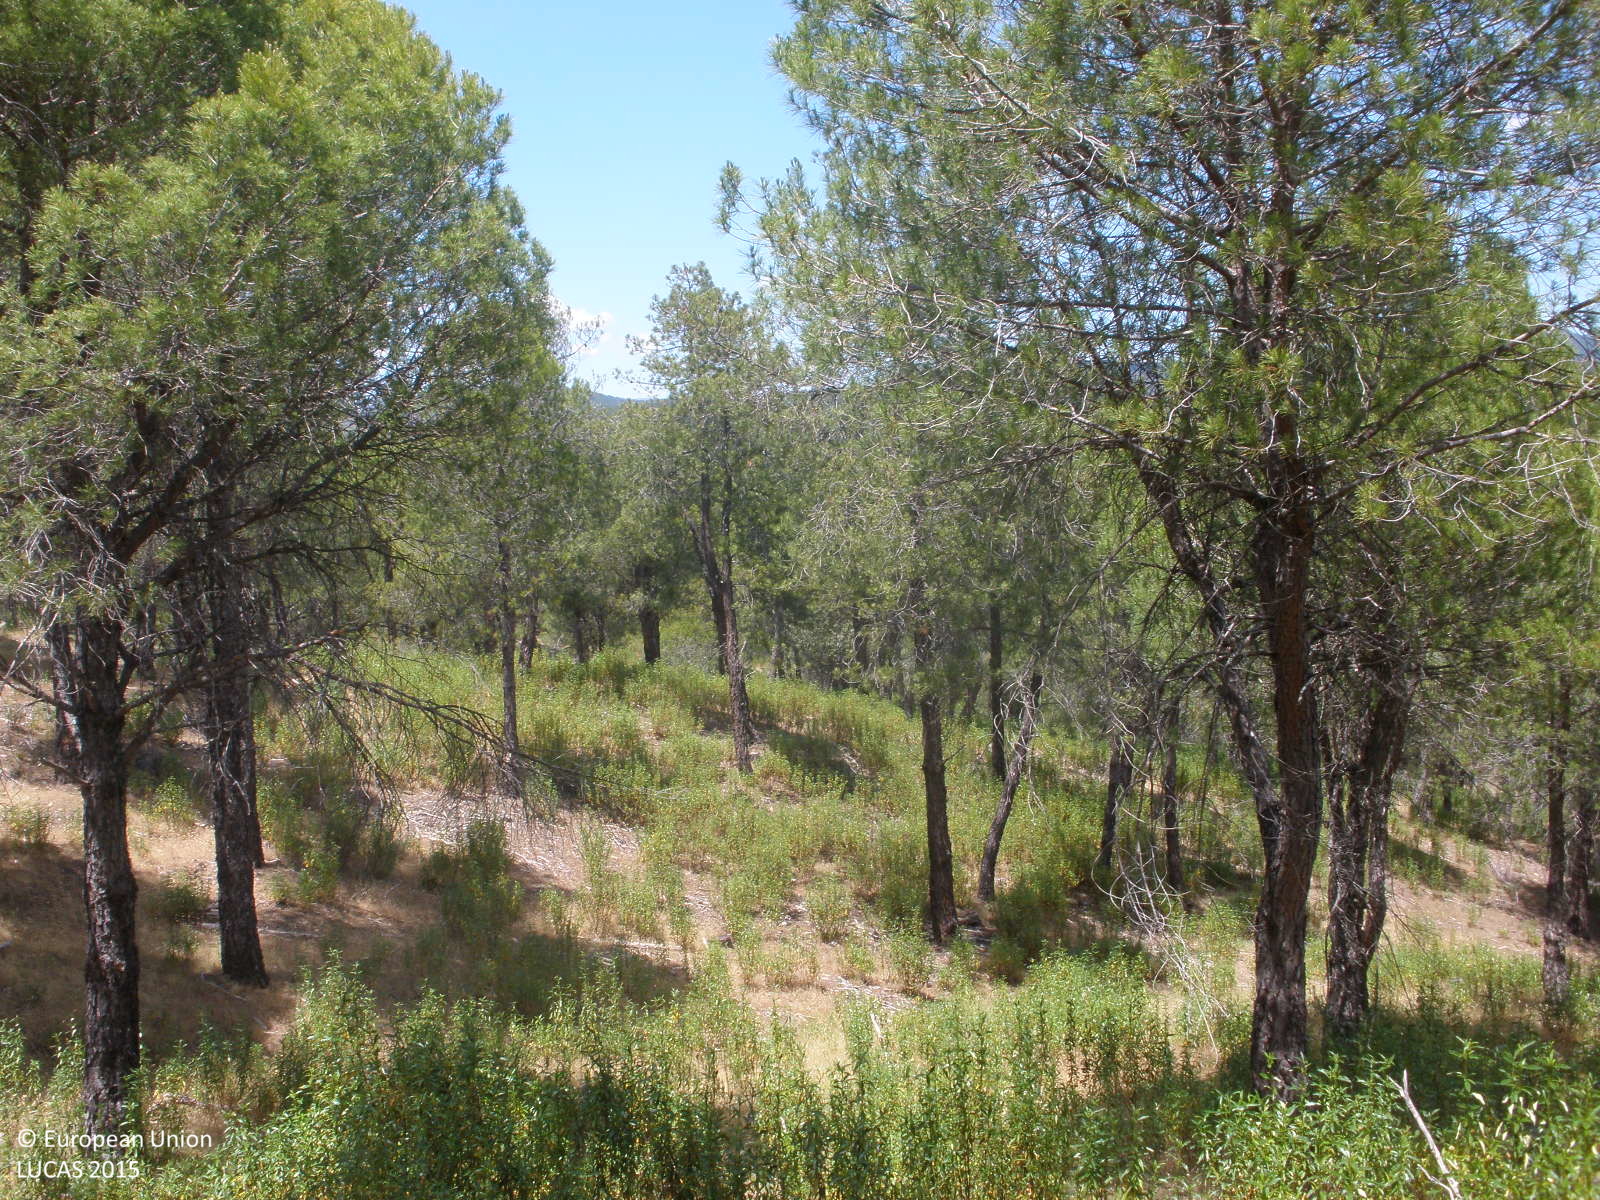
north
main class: Woodland
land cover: Pine dominated coniferous woodland
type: coniferous forest of the mediterranean region
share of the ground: 50 - 75 %
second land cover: Shrubland without tree cover
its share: 10 - 25 %
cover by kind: coniferous forest trees 50 %, shrubs 30 %, herbaceous plants 20 %
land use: Forestry
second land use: Agriculture (excluding fallow land and kitchen gardens)
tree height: > 5 m
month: May
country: ES
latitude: 40.2743
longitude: -6.0812
